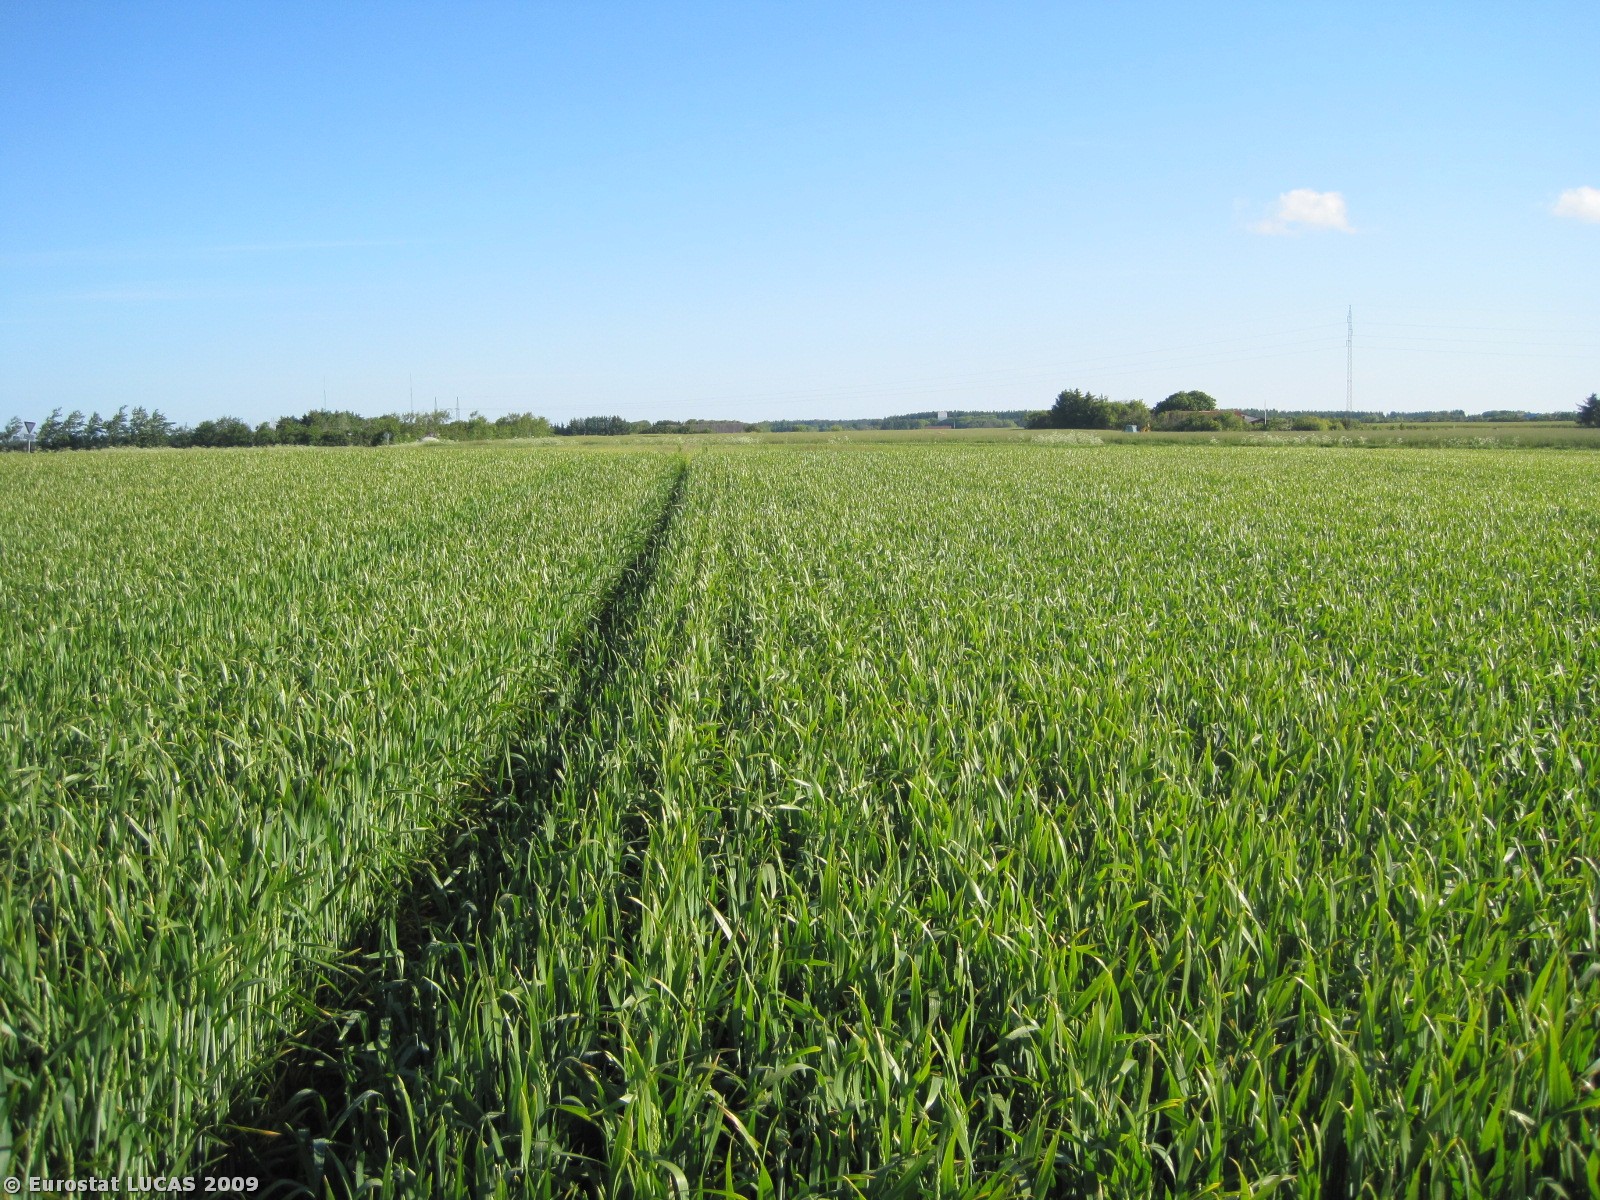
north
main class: Cropland
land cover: Common wheat
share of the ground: > 75 %
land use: Agriculture (excluding fallow land and kitchen gardens)
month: June
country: DK
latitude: 57.4641
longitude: 9.8502
